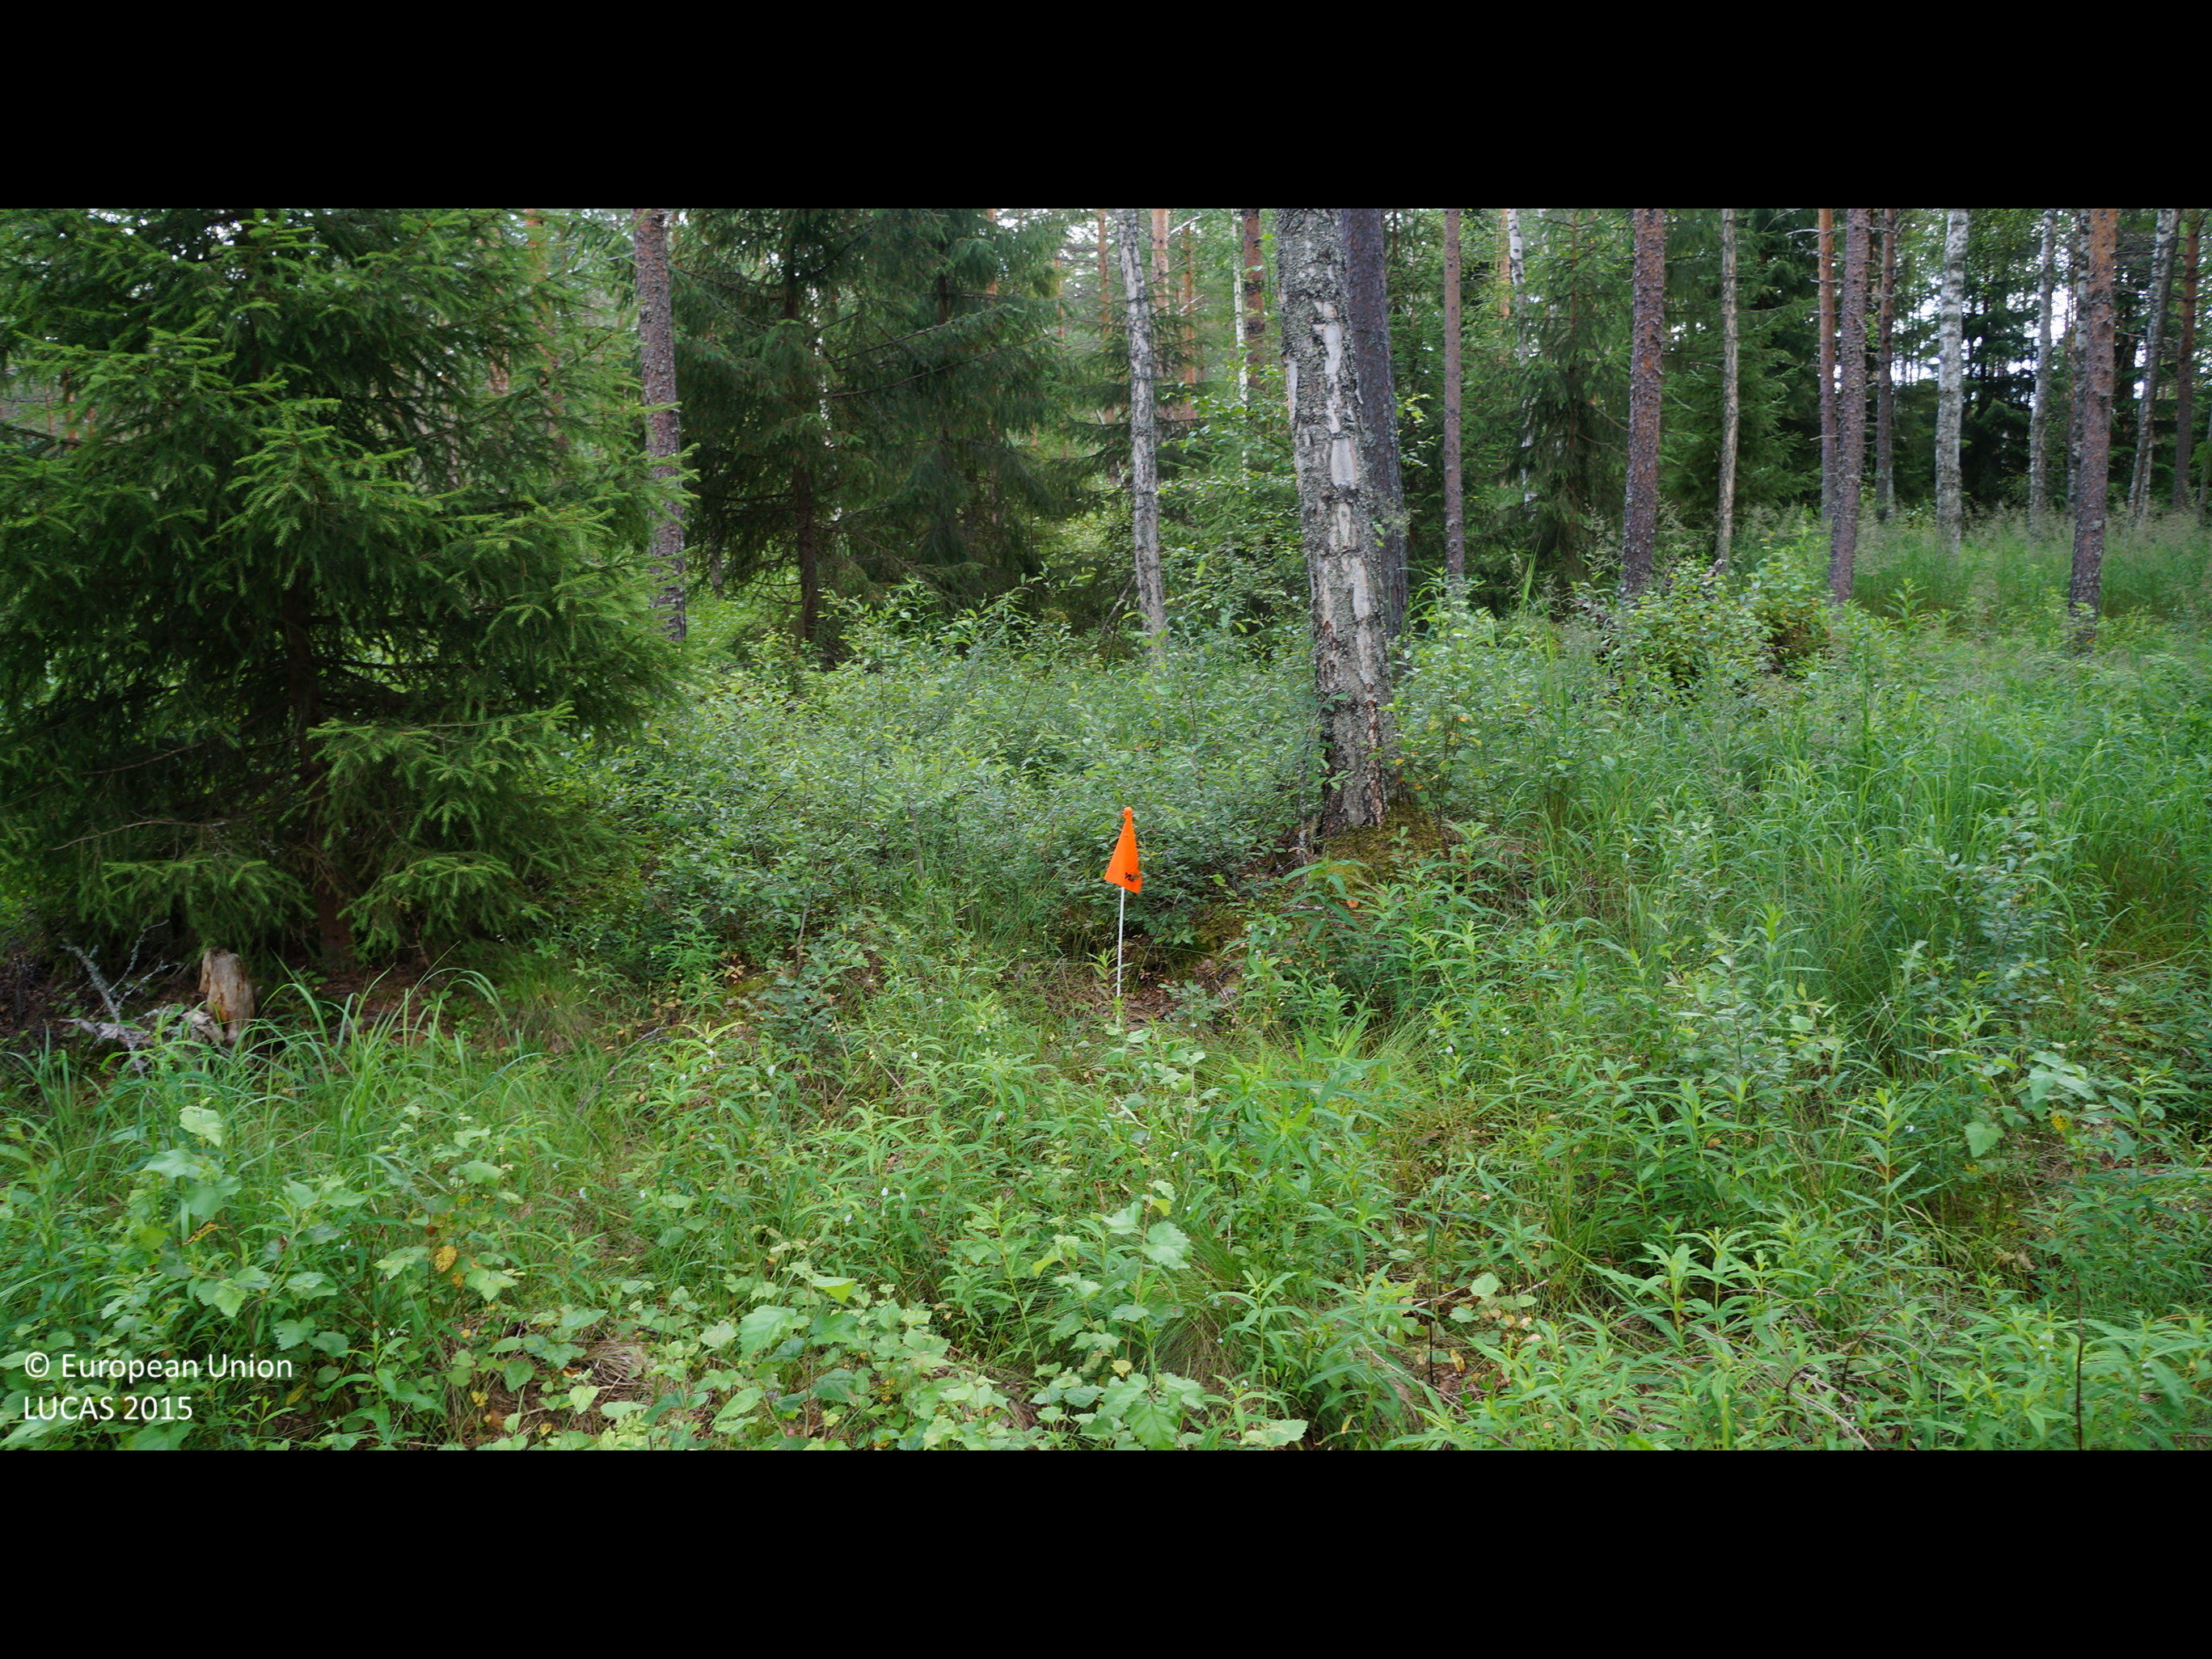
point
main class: Woodland
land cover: Pine dominated mixed woodland
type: boreal forest
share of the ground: 50 - 75 %
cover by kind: coniferous forest trees 30 %, herbaceous plants 30 %, broadleaved forest trees 20 %, shrubs 20 %
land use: Forestry
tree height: > 5 m
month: July
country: FI
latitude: 64.0157
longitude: 24.3717
